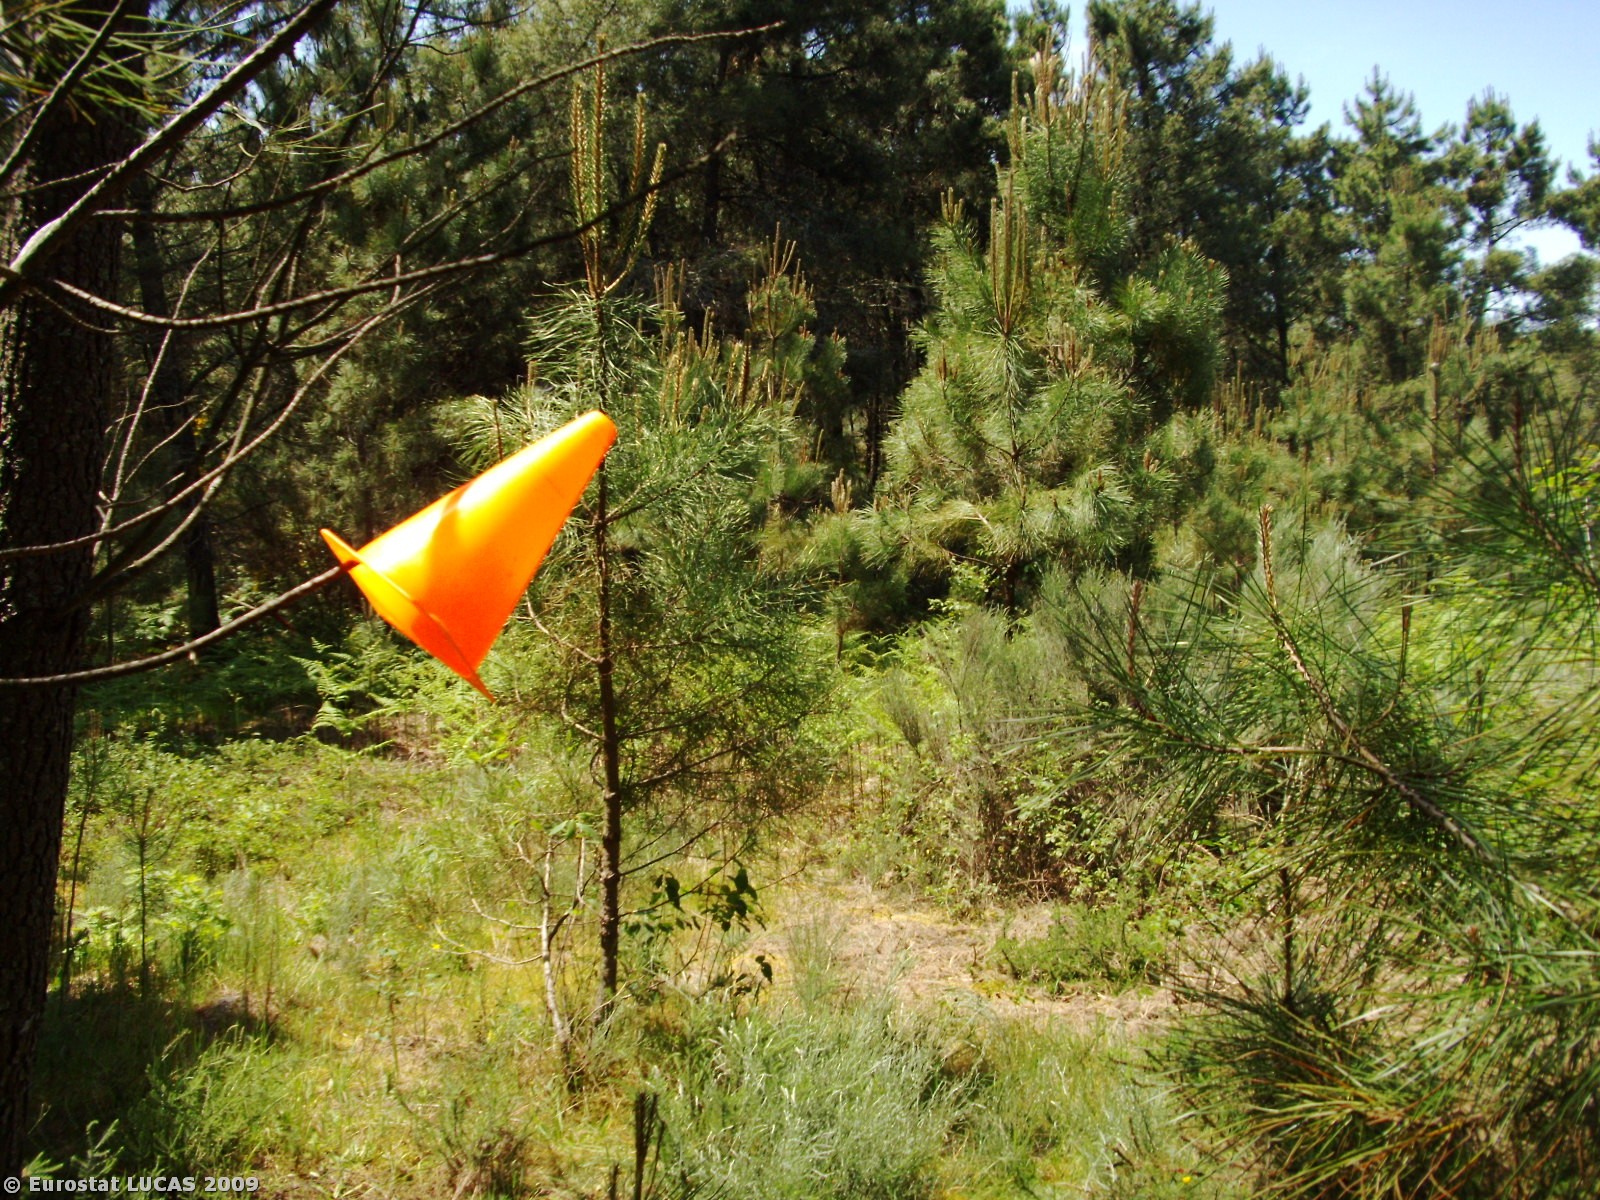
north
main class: Woodland
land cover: Coniferous woodland
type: coniferous forest of the mediterranean region
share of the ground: 50 - 75 %
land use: Forestry
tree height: > 5 m
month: May
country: PT
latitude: 40.7670
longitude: -7.4947
